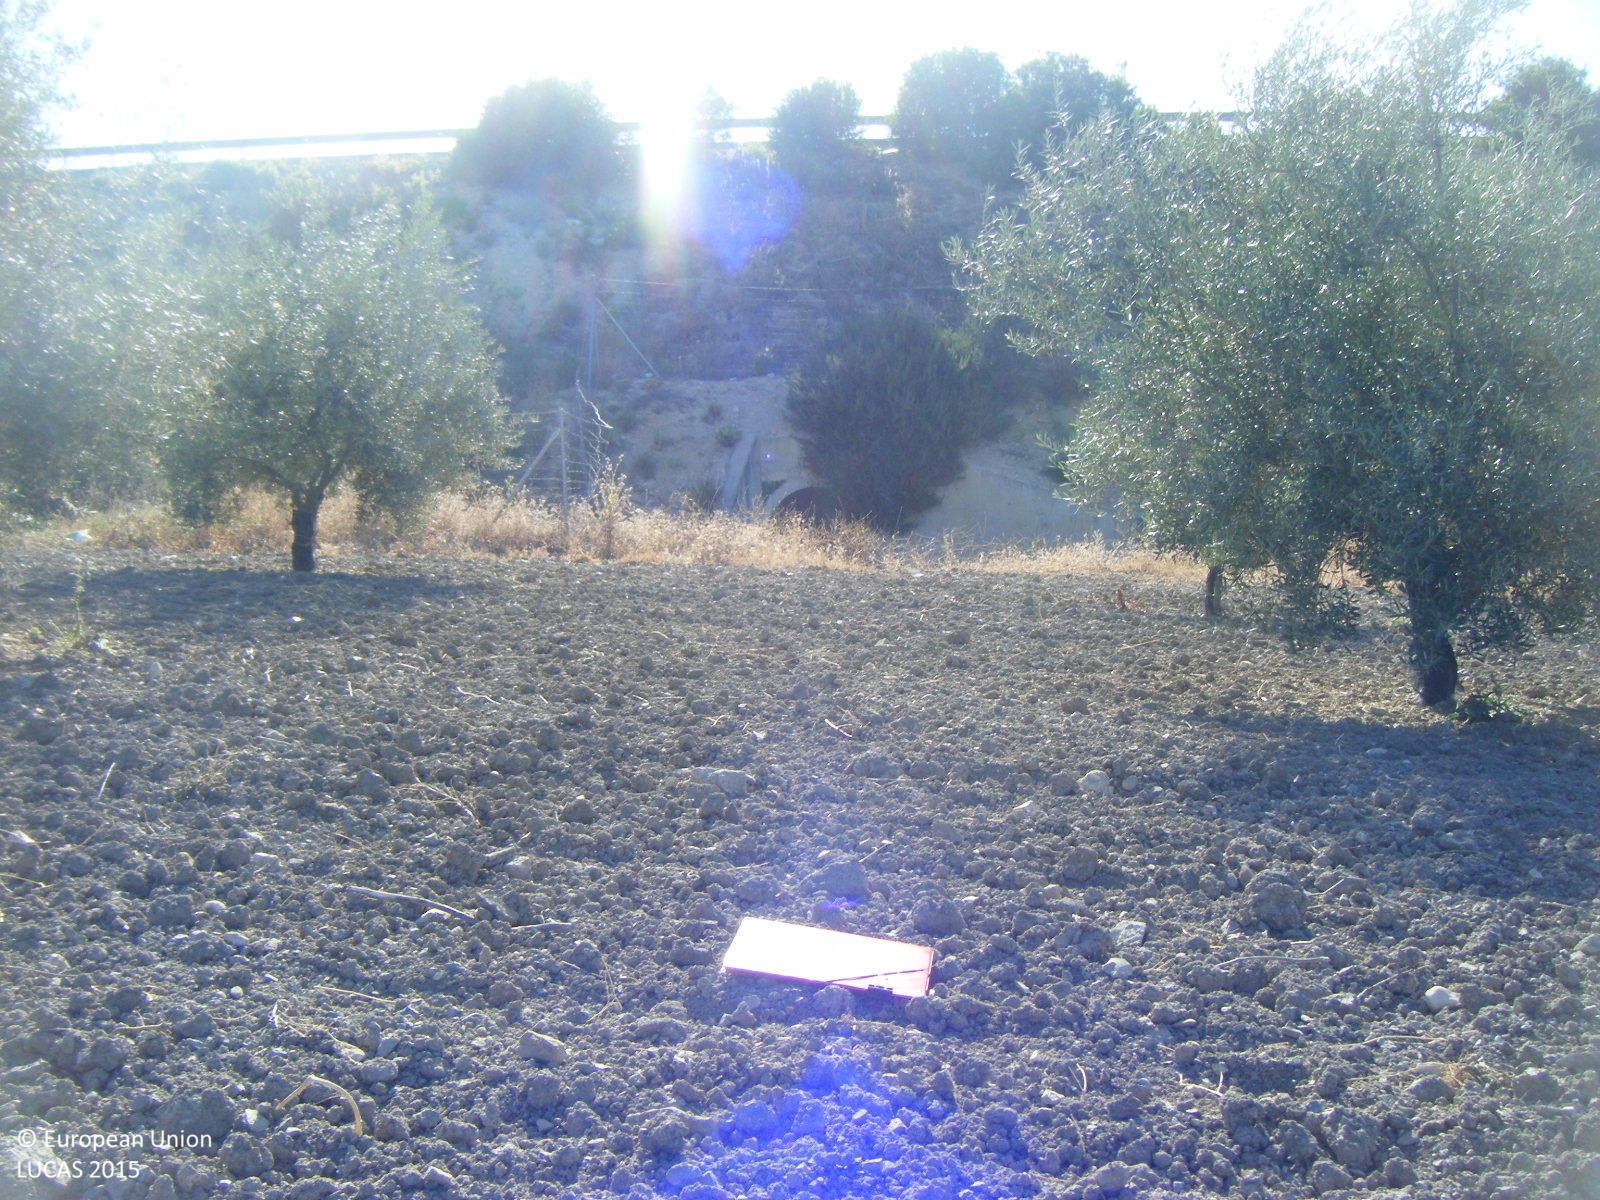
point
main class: Cropland
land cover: Olive groves
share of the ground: < 10 %
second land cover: Other bare soil
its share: > 75 %
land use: Agriculture (excluding fallow land and kitchen gardens)
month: June
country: ES
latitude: 37.2959
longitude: -4.4739
